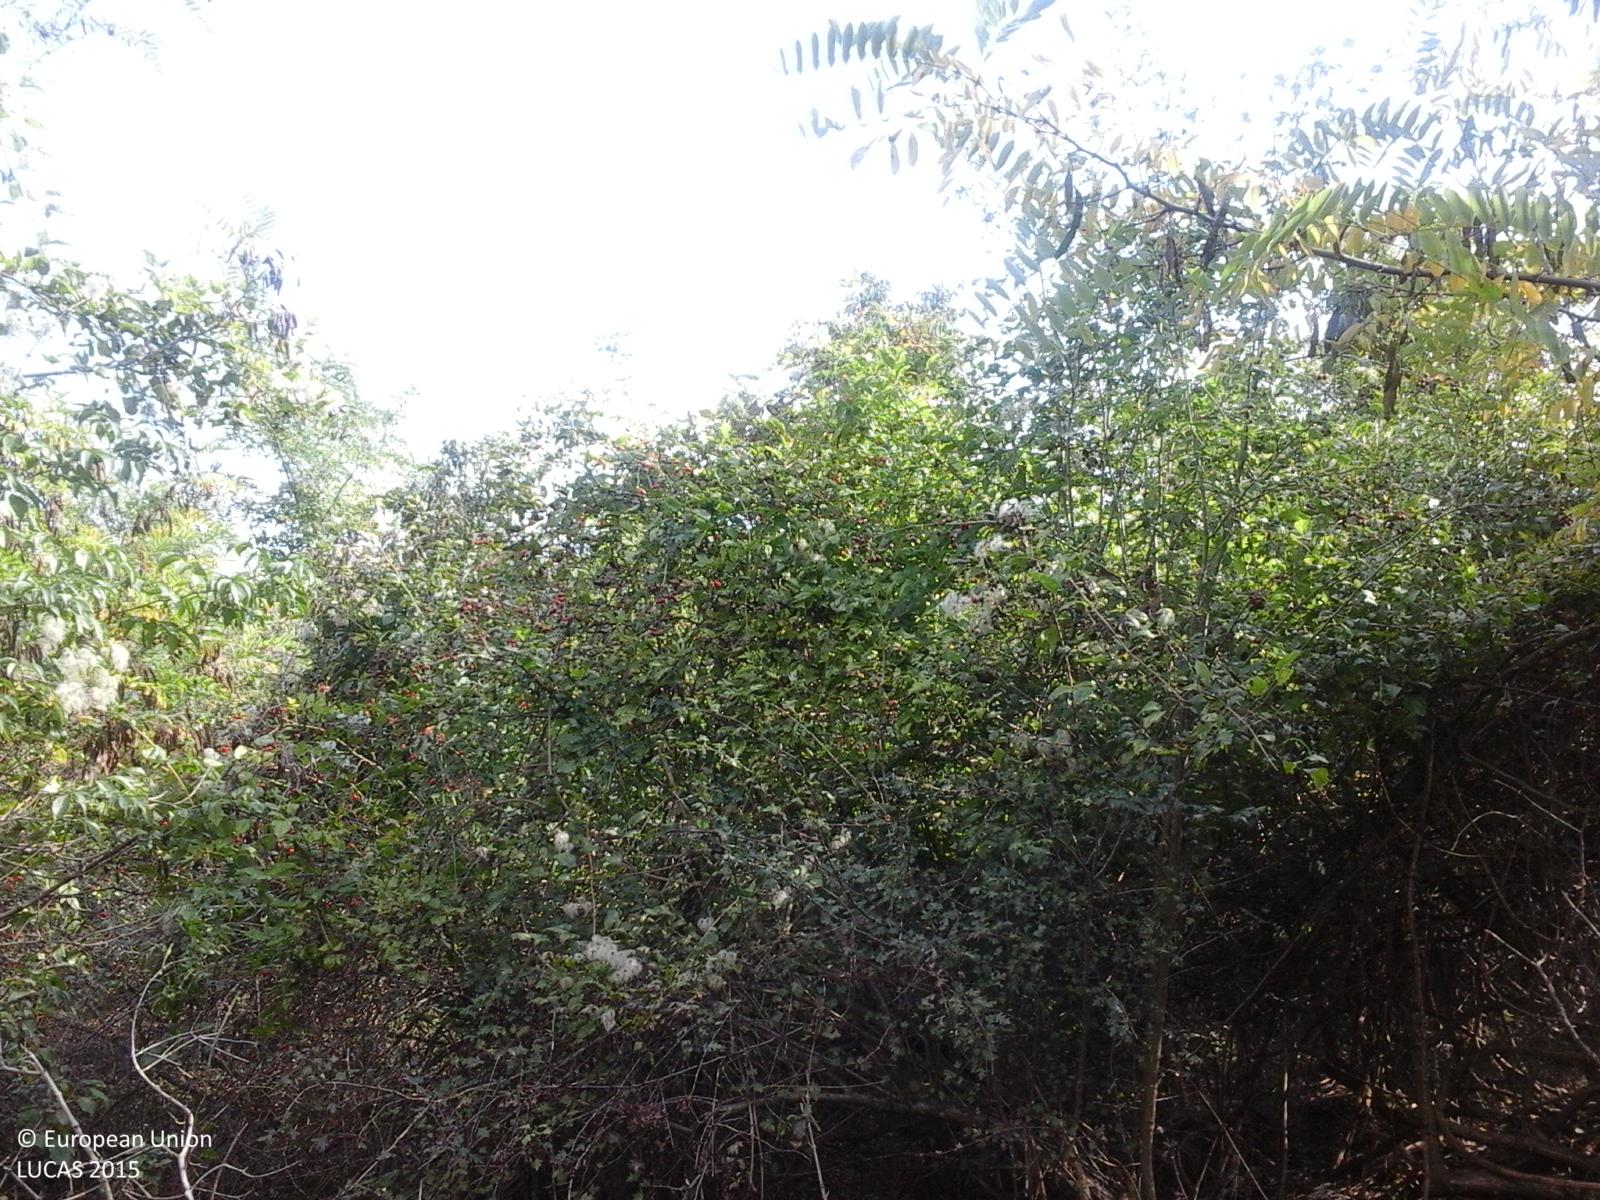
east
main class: Woodland
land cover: Broadleaved woodland
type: exotic forest
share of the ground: > 75 %
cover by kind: broadleaved forest trees 100 %
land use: Forestry
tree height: > 5 m
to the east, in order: Broadleaved woodland; Grassland with sparse tree/shrub cover
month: October
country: RO
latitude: 46.4143
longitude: 24.1162
